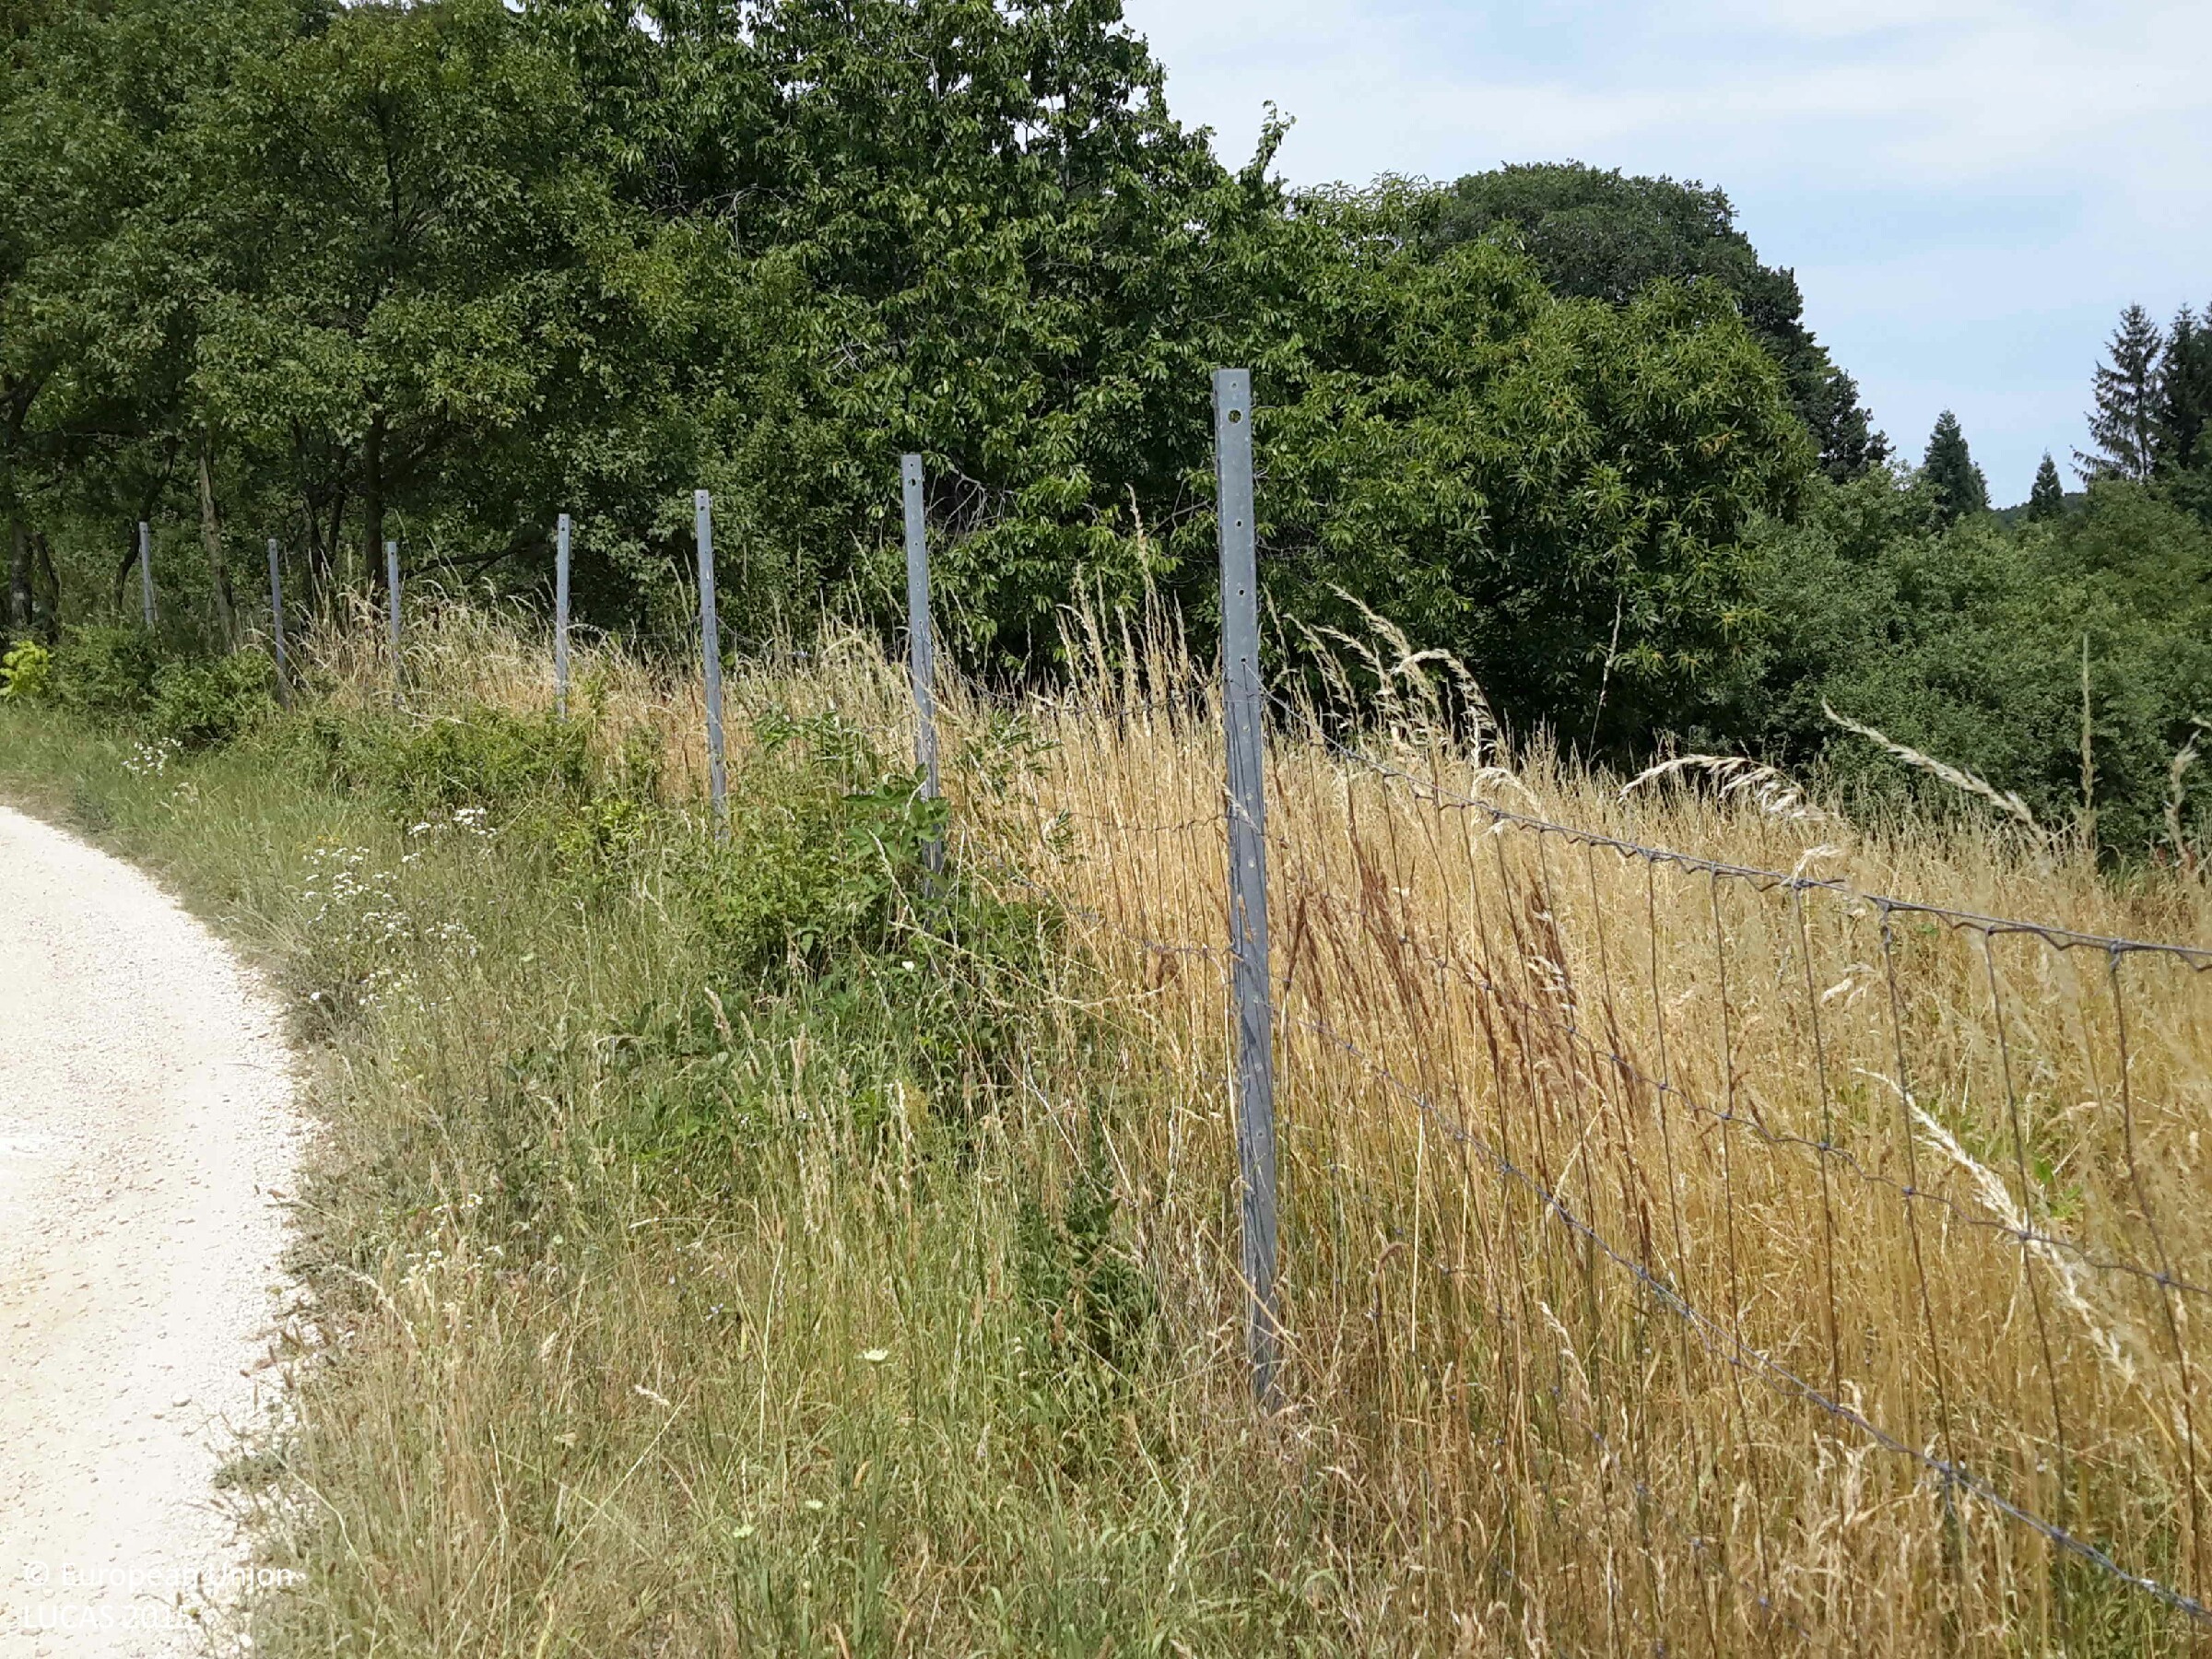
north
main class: Cropland
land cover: Other fruit trees and berries
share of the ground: 25 - 50 %
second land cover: Spontaneously vegetated surfaces
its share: 50 - 75 %
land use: Abandoned areas
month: July
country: HU
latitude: 47.6533
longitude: 16.4880
